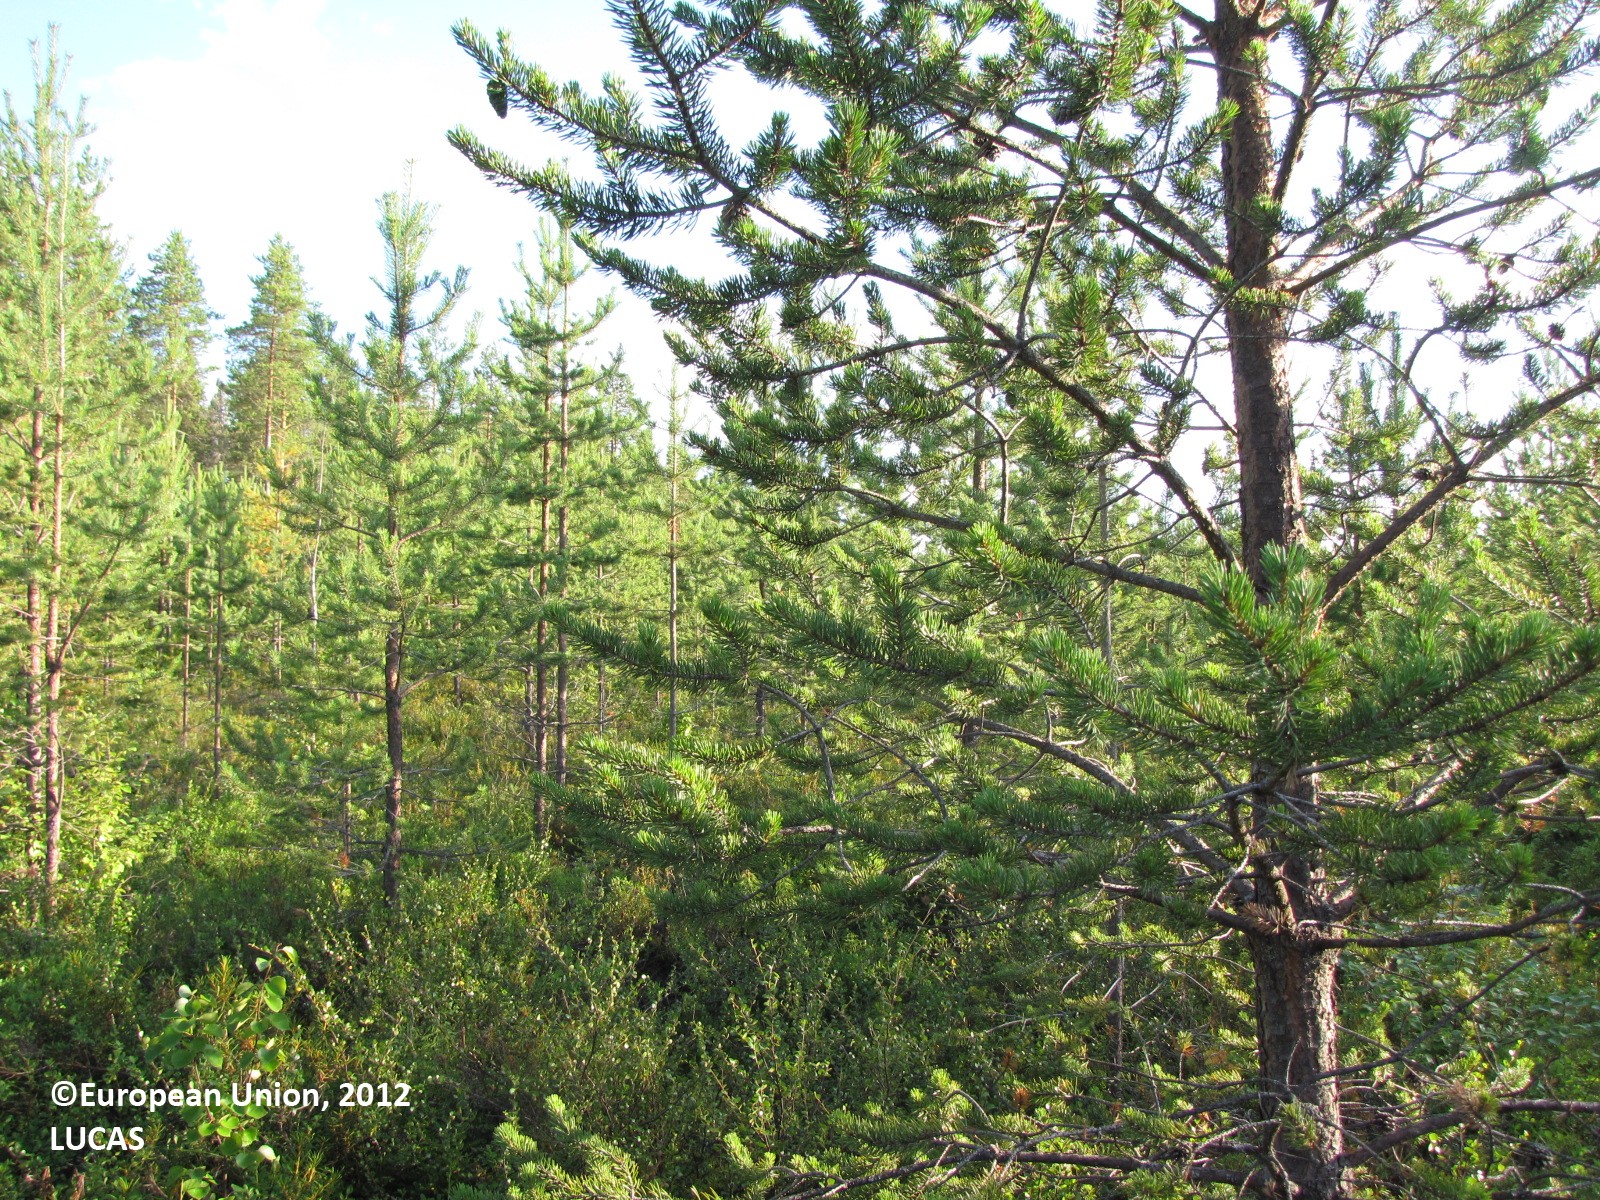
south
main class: Woodland
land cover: Pine dominated coniferous woodland
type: boreal forest
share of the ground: 50 - 75 %
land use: Forestry
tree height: < 5 m
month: July
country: FI
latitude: 66.7013
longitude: 24.4740
